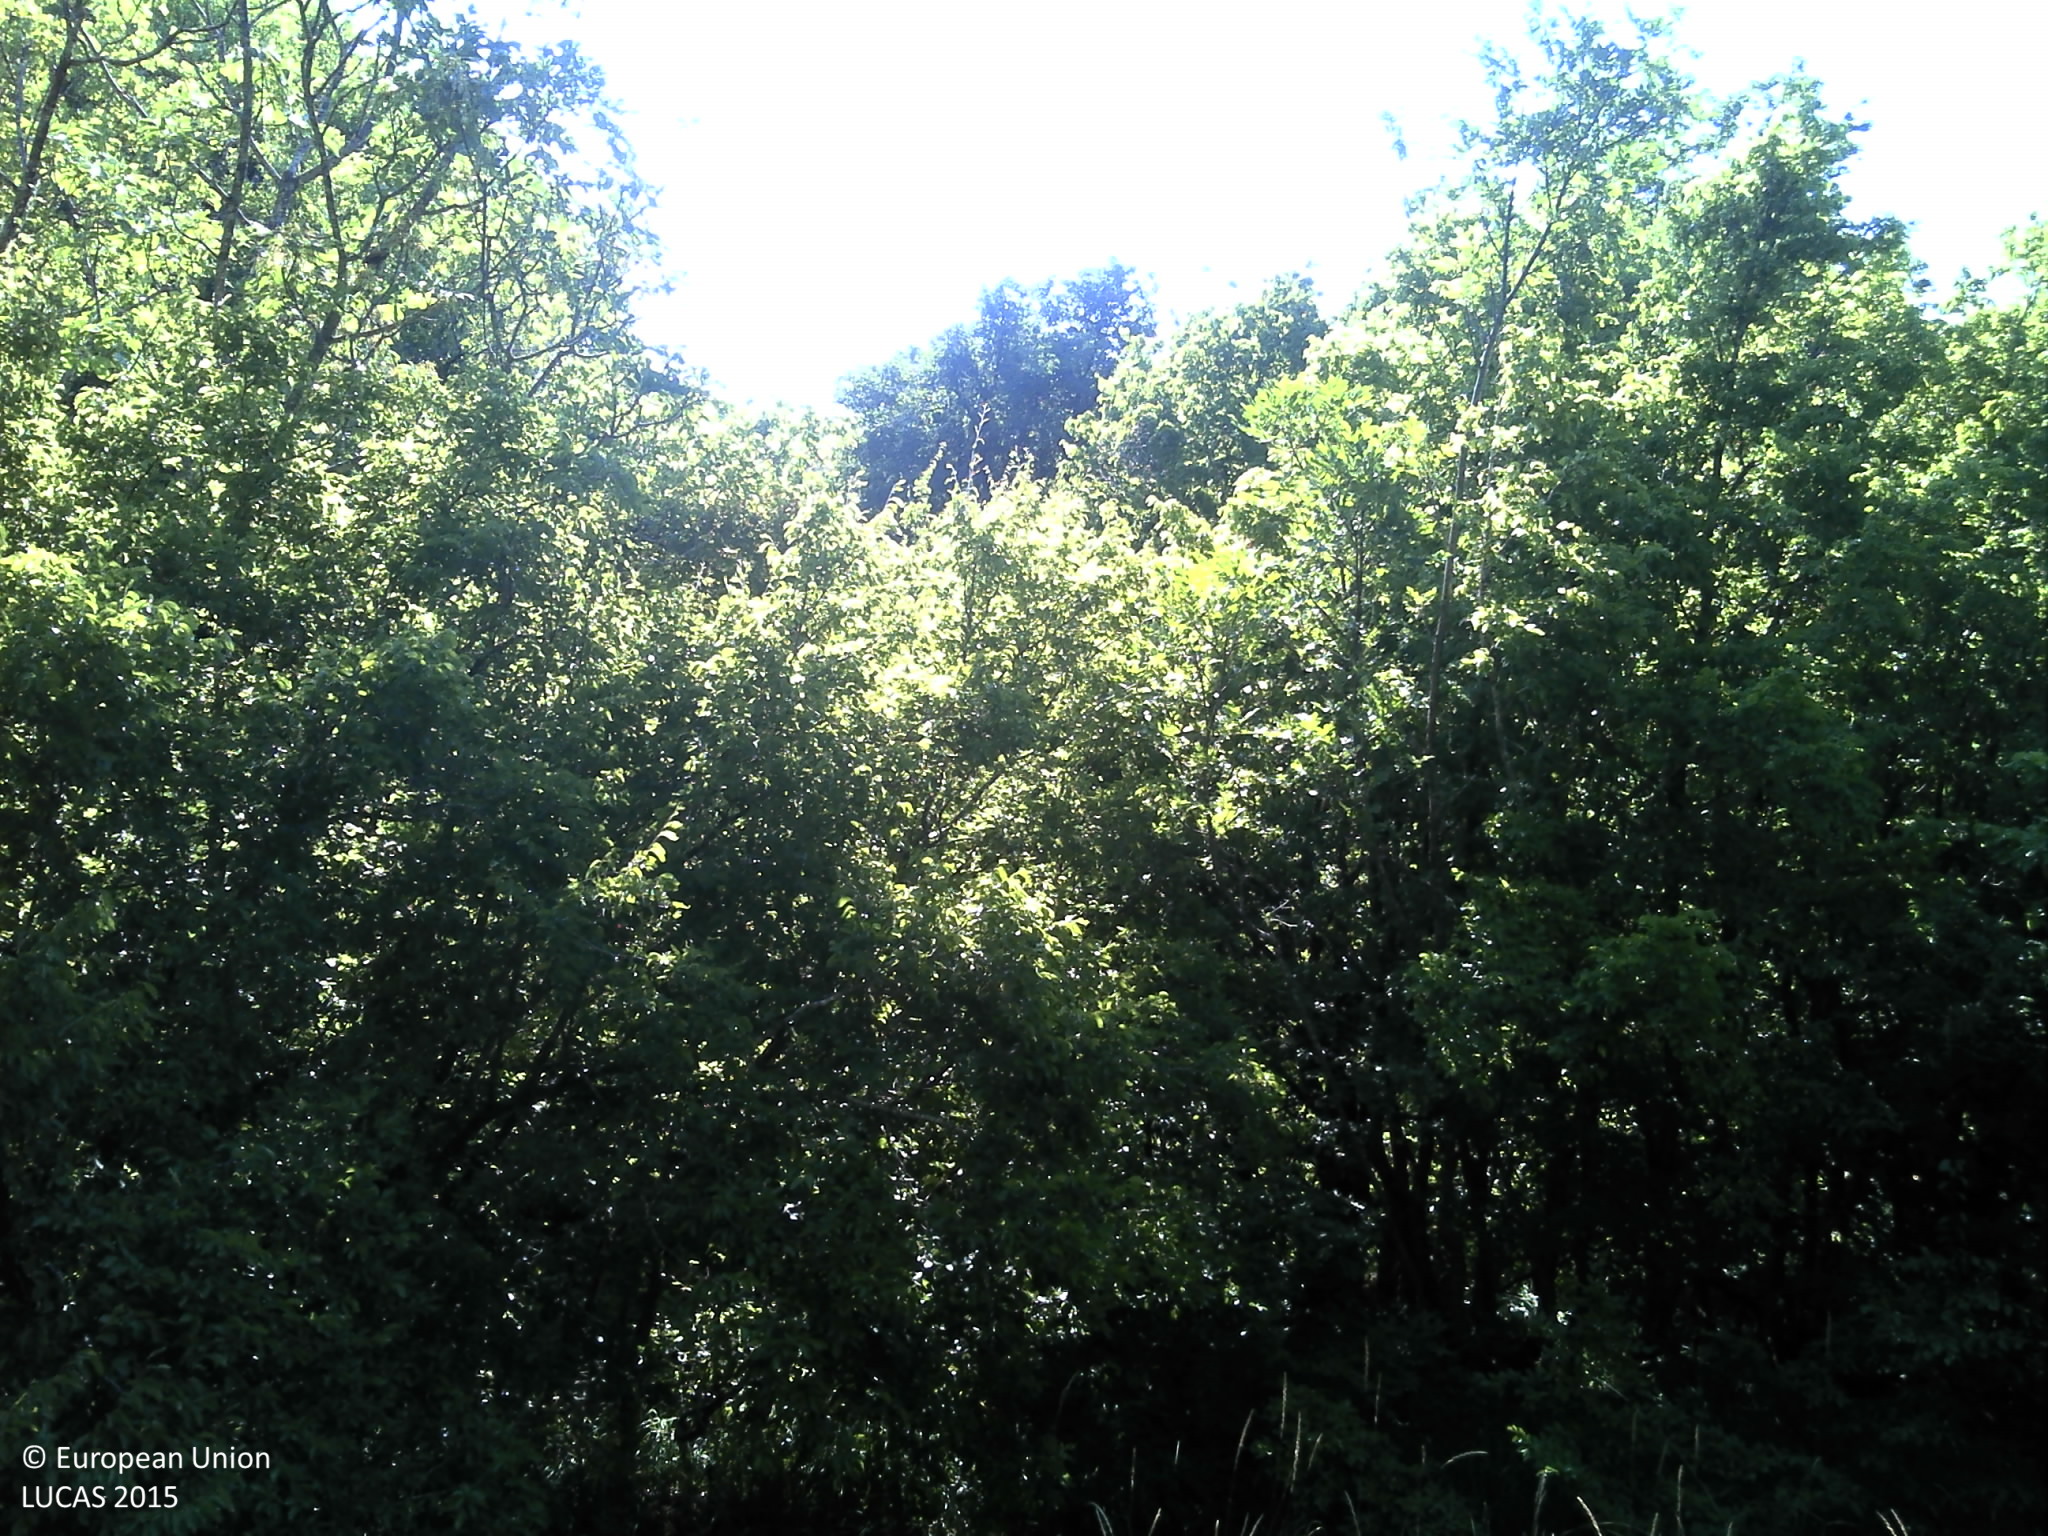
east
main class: Woodland
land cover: Broadleaved woodland
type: thermophilous deciduous forest
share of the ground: 25 - 50 %
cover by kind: shrubs 45 %, broadleaved forest trees 40 %, herbaceous plants 10 %, consolidated bare surface 5 %
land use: Semi-natural and natural areas not in use
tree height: > 5 m
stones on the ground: < 10 %
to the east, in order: Broadleaved woodland; Dry stone walls; Grassland with sparse tree/shrub cover; Shrubland with sparse tree cover; Dry stone walls; Shrubland with sparse tree cover; Dry stone walls; Shrubland with sparse tree cover
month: July
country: HR
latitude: 43.5342
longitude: 17.0082
